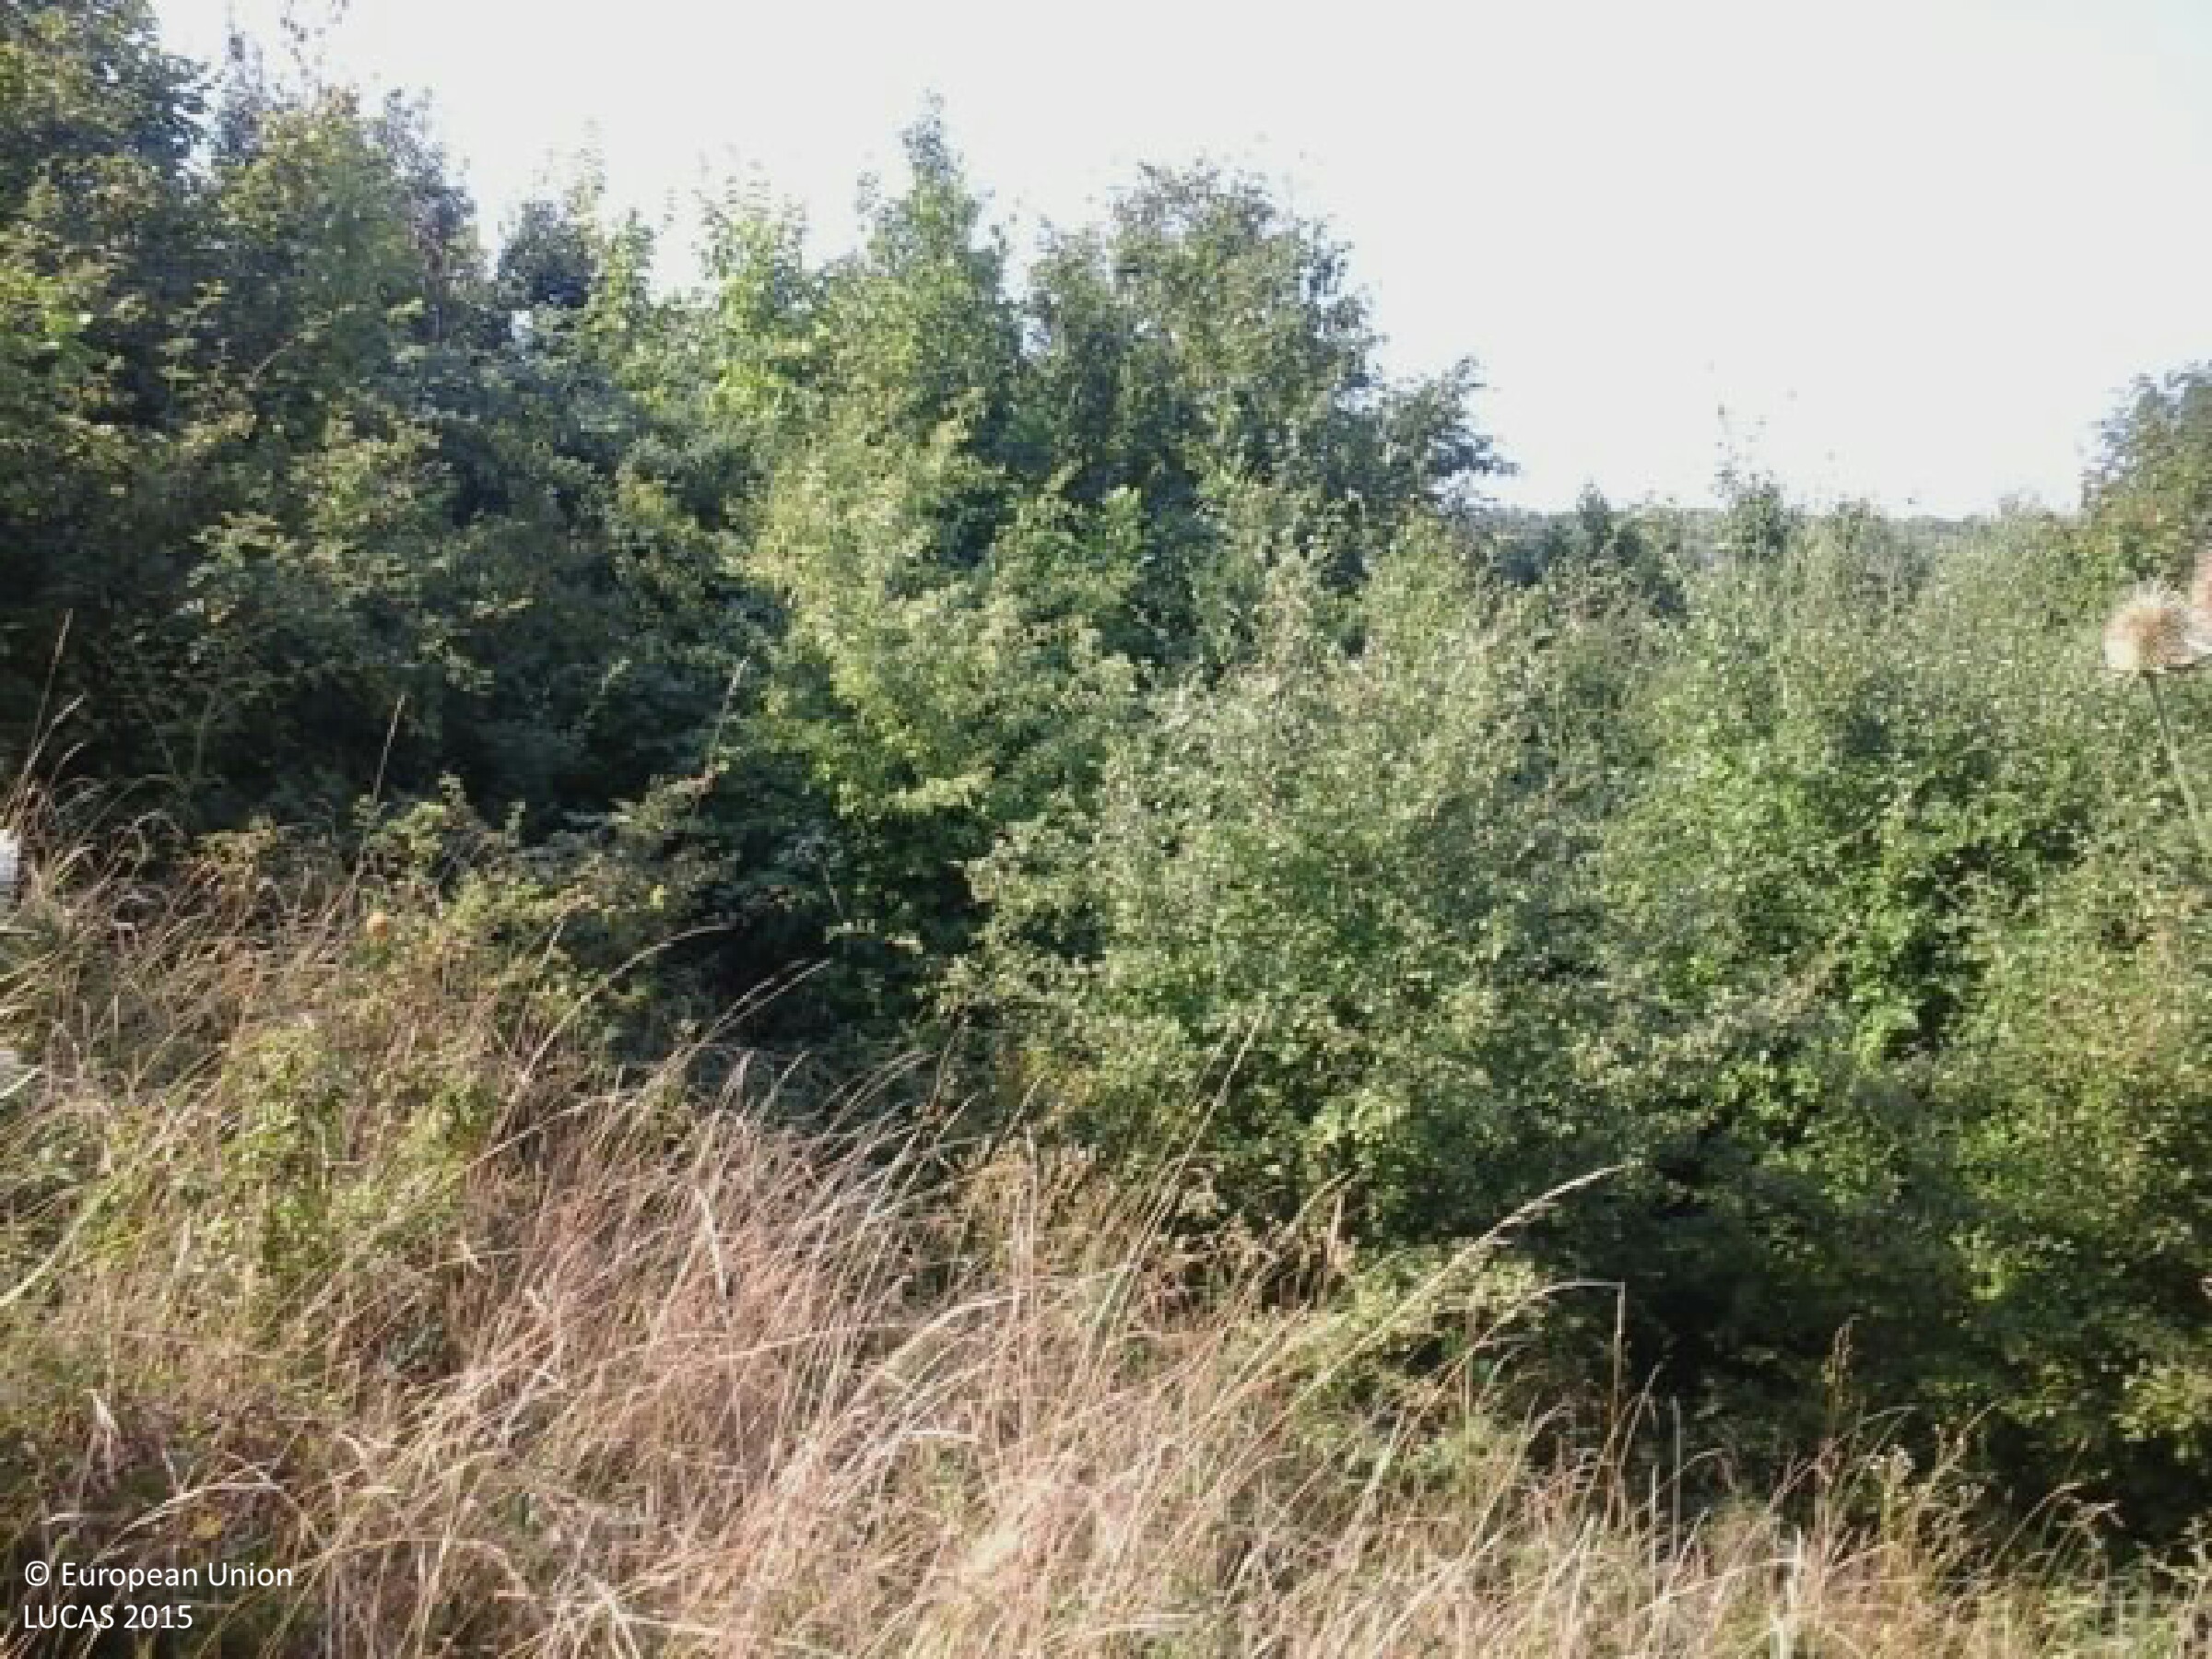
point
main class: Woodland
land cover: Broadleaved woodland
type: mesophytic deciduous forest
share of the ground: > 75 %
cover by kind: broadleaved forest trees 90 %, shrubs 5 %, herbaceous plants 5 %
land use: Forestry
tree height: > 5 m
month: August
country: HU
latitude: 46.2375
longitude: 17.9296
